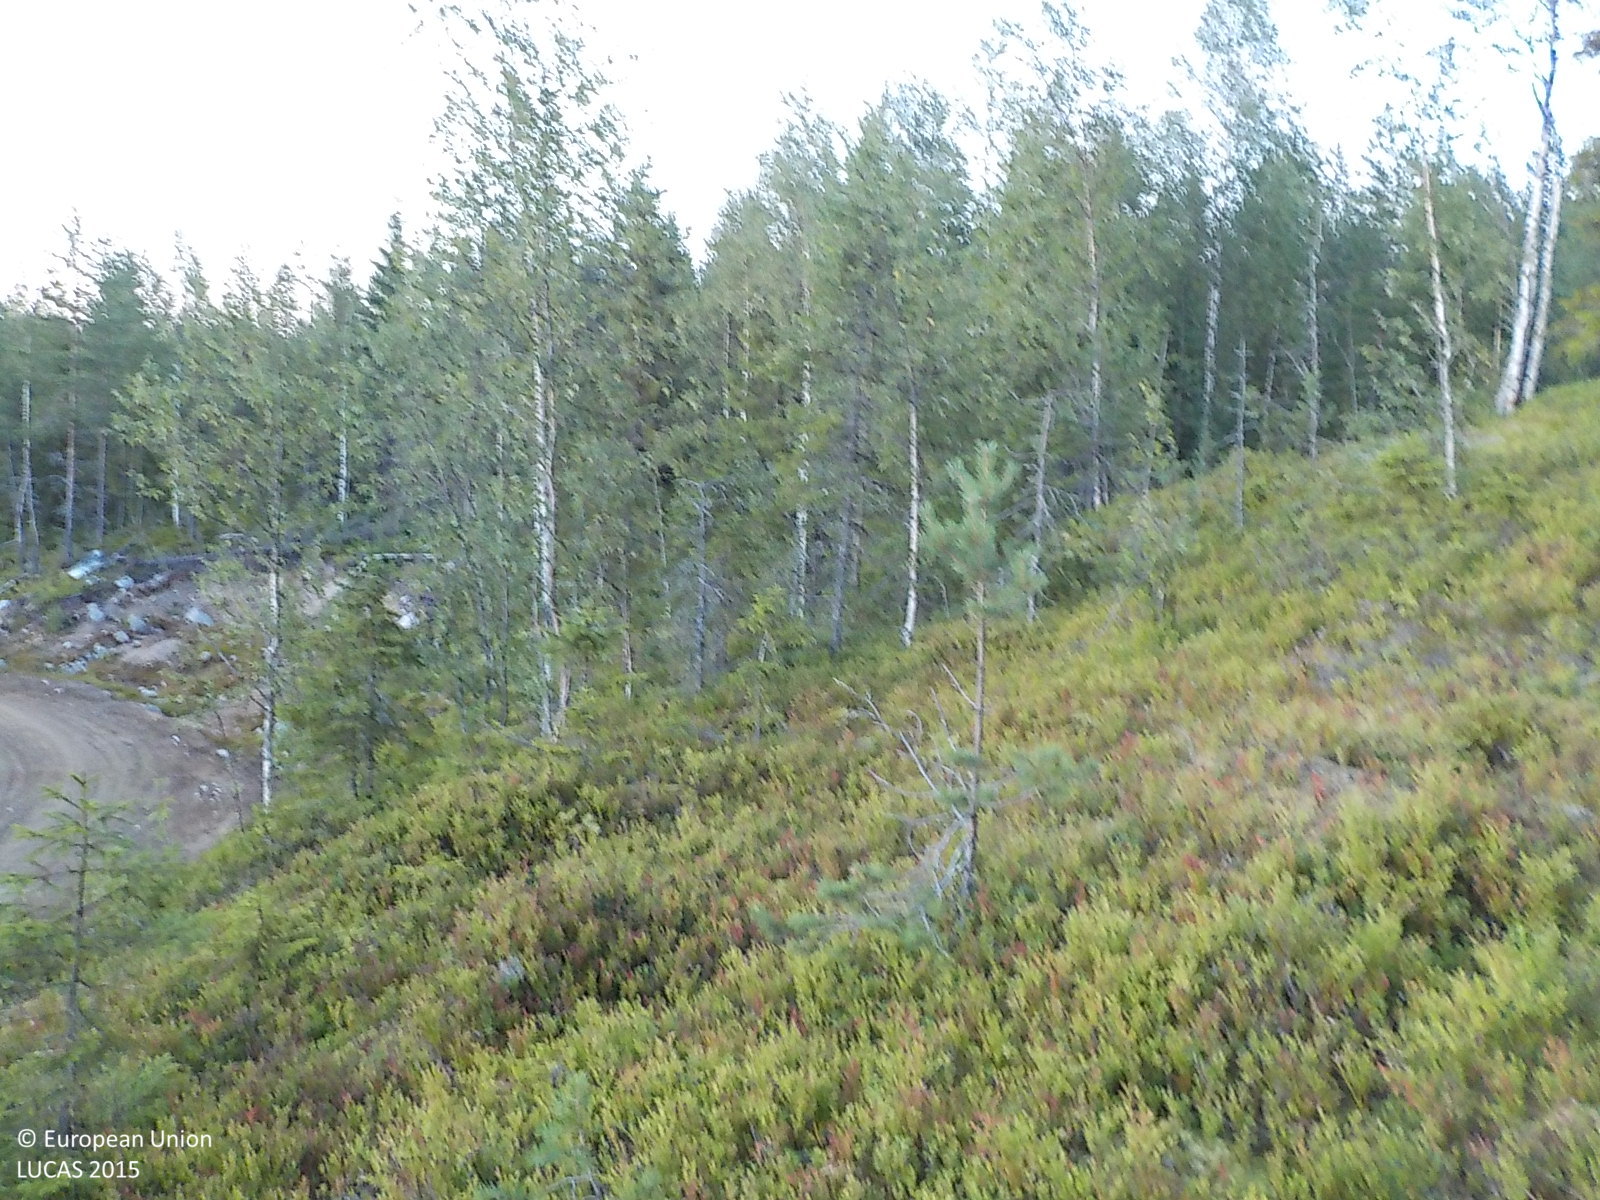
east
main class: Woodland
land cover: Pine dominated mixed woodland
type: boreal forest
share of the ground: 10 - 25 %
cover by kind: shrubs 80 %, coniferous forest trees 15 %, broadleaved forest trees 5 %
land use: Forestry
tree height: > 5 m
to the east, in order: Pine dominated mixed woodland; Pine dominated coniferous woodland
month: August
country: SE
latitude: 63.4792
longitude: 18.8296
